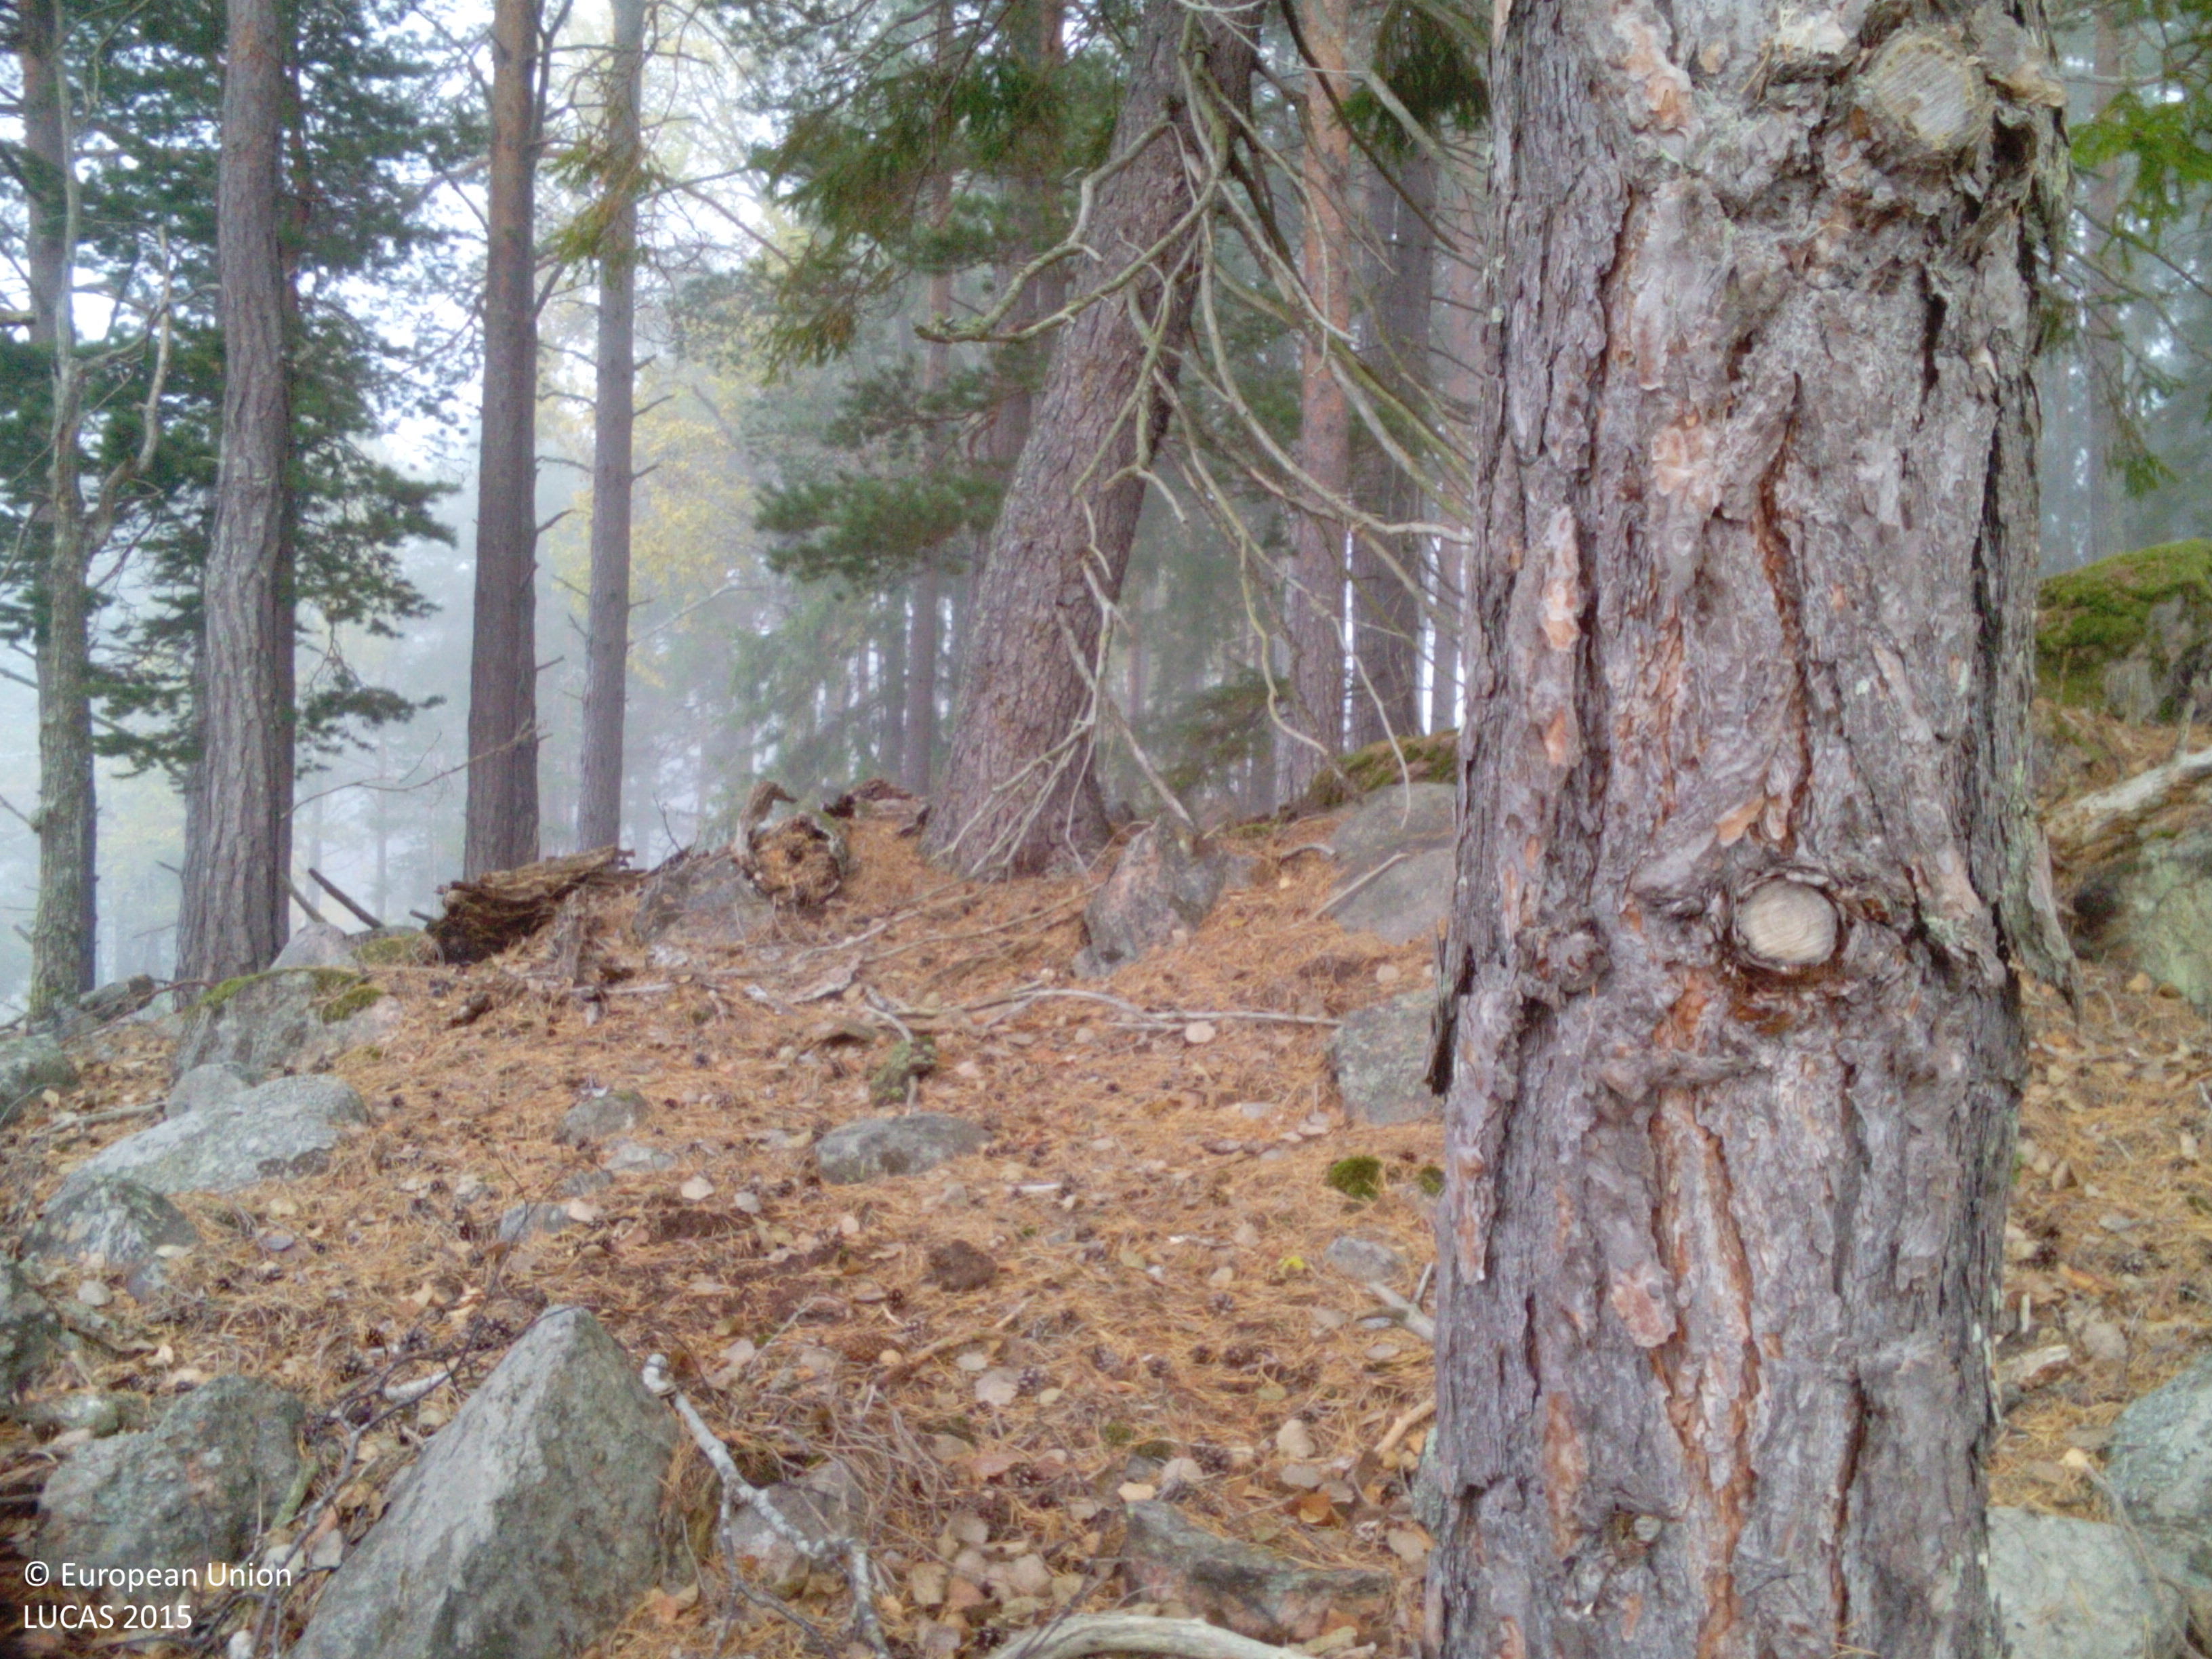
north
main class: Woodland
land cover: Pine dominated coniferous woodland
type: boreal forest
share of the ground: 25 - 50 %
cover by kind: coniferous forest trees 45 %
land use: Forestry
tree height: > 5 m
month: October
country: SE
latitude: 58.9448
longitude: 16.5468
